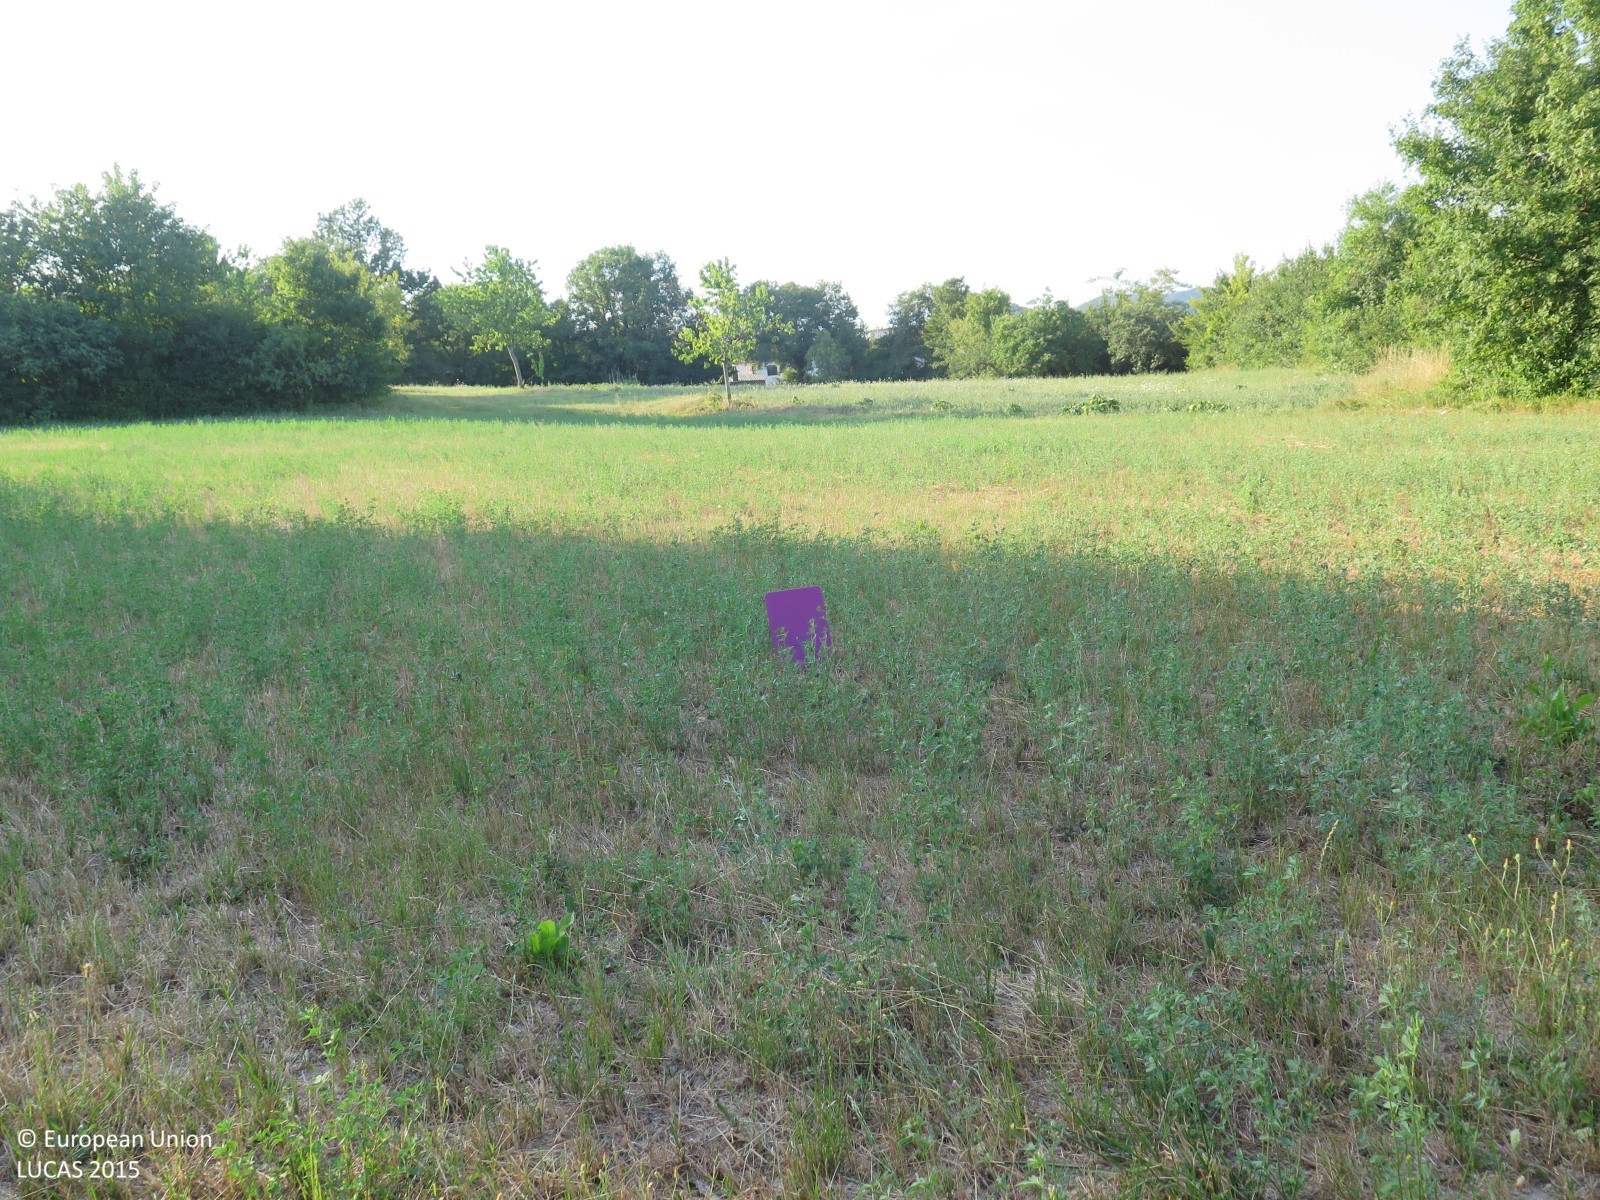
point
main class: Cropland
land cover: Lucerne
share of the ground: > 75 %
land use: Agriculture (excluding fallow land and kitchen gardens)
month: July
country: HR
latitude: 45.2100
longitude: 14.0564
